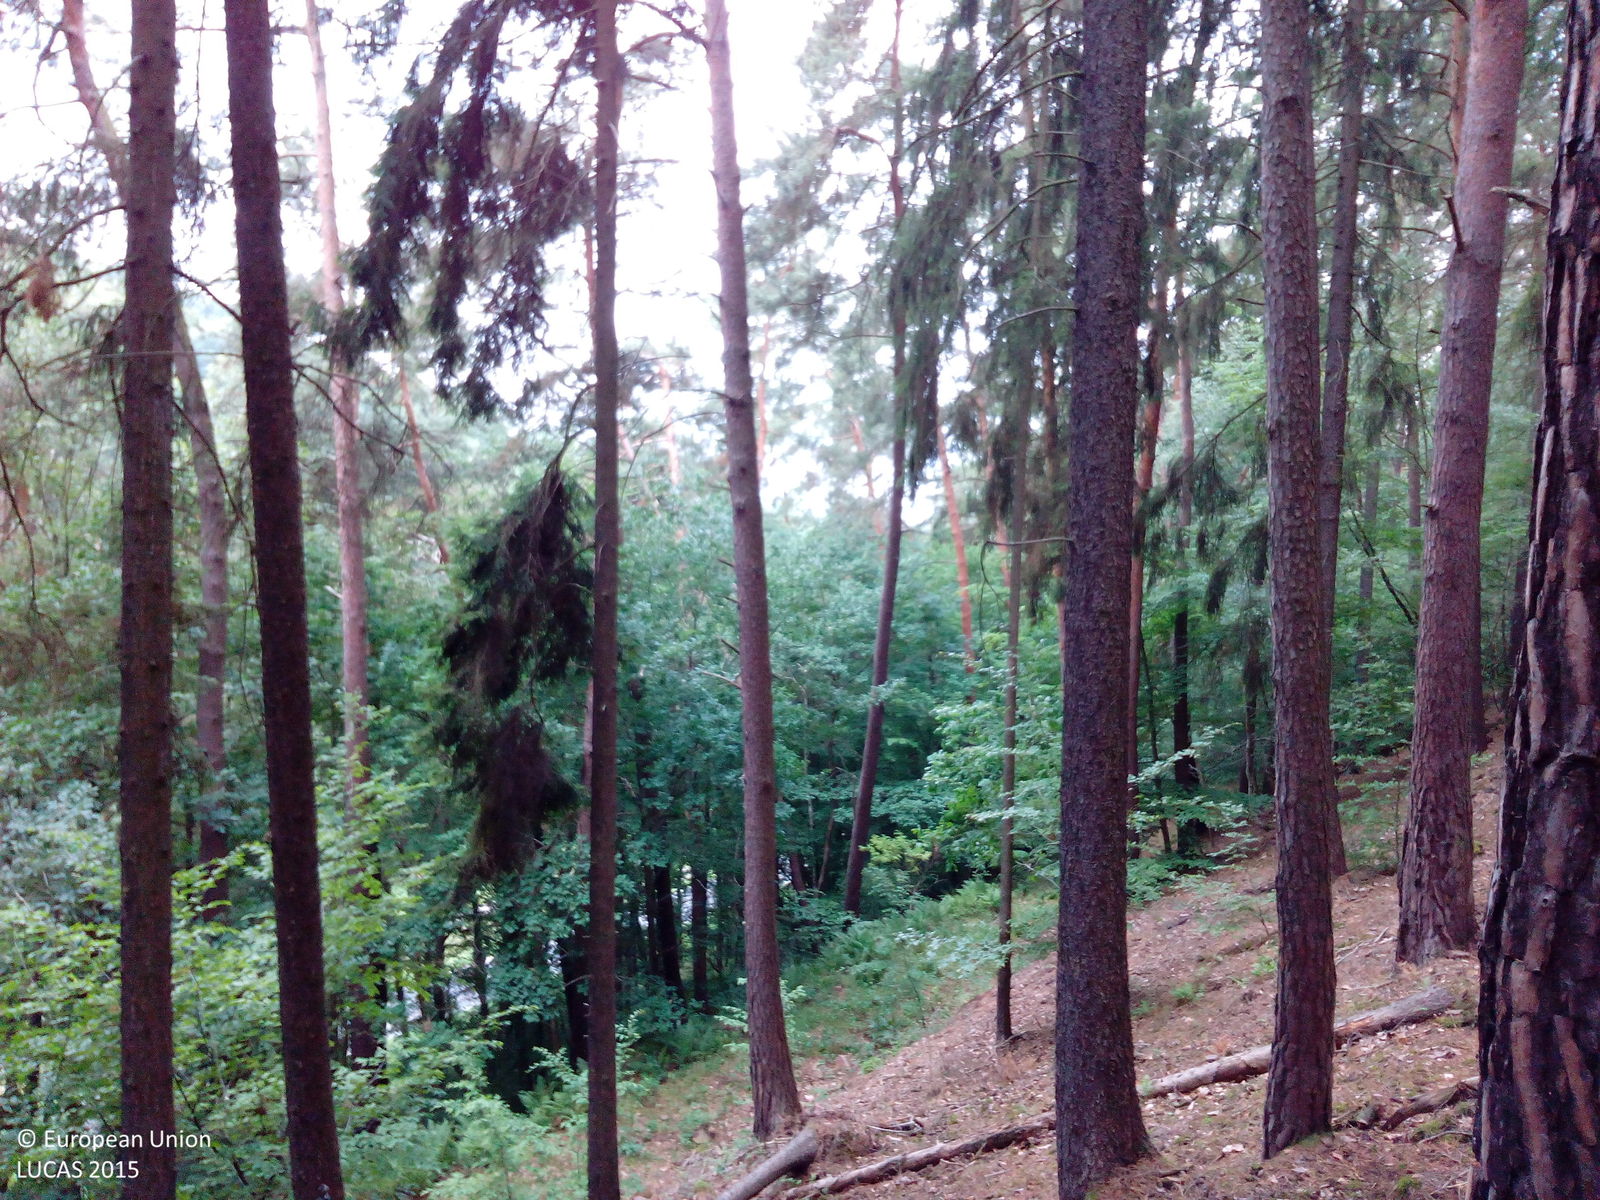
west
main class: Woodland
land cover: Pine dominated coniferous woodland
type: hemiboreal forest and nemoral coniferous forest and mixed broadleaved-coniferous forest
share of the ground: > 75 %
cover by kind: coniferous forest trees 100 %
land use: Forestry
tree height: > 5 m
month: July
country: DE
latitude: 51.6225
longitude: 9.9567
